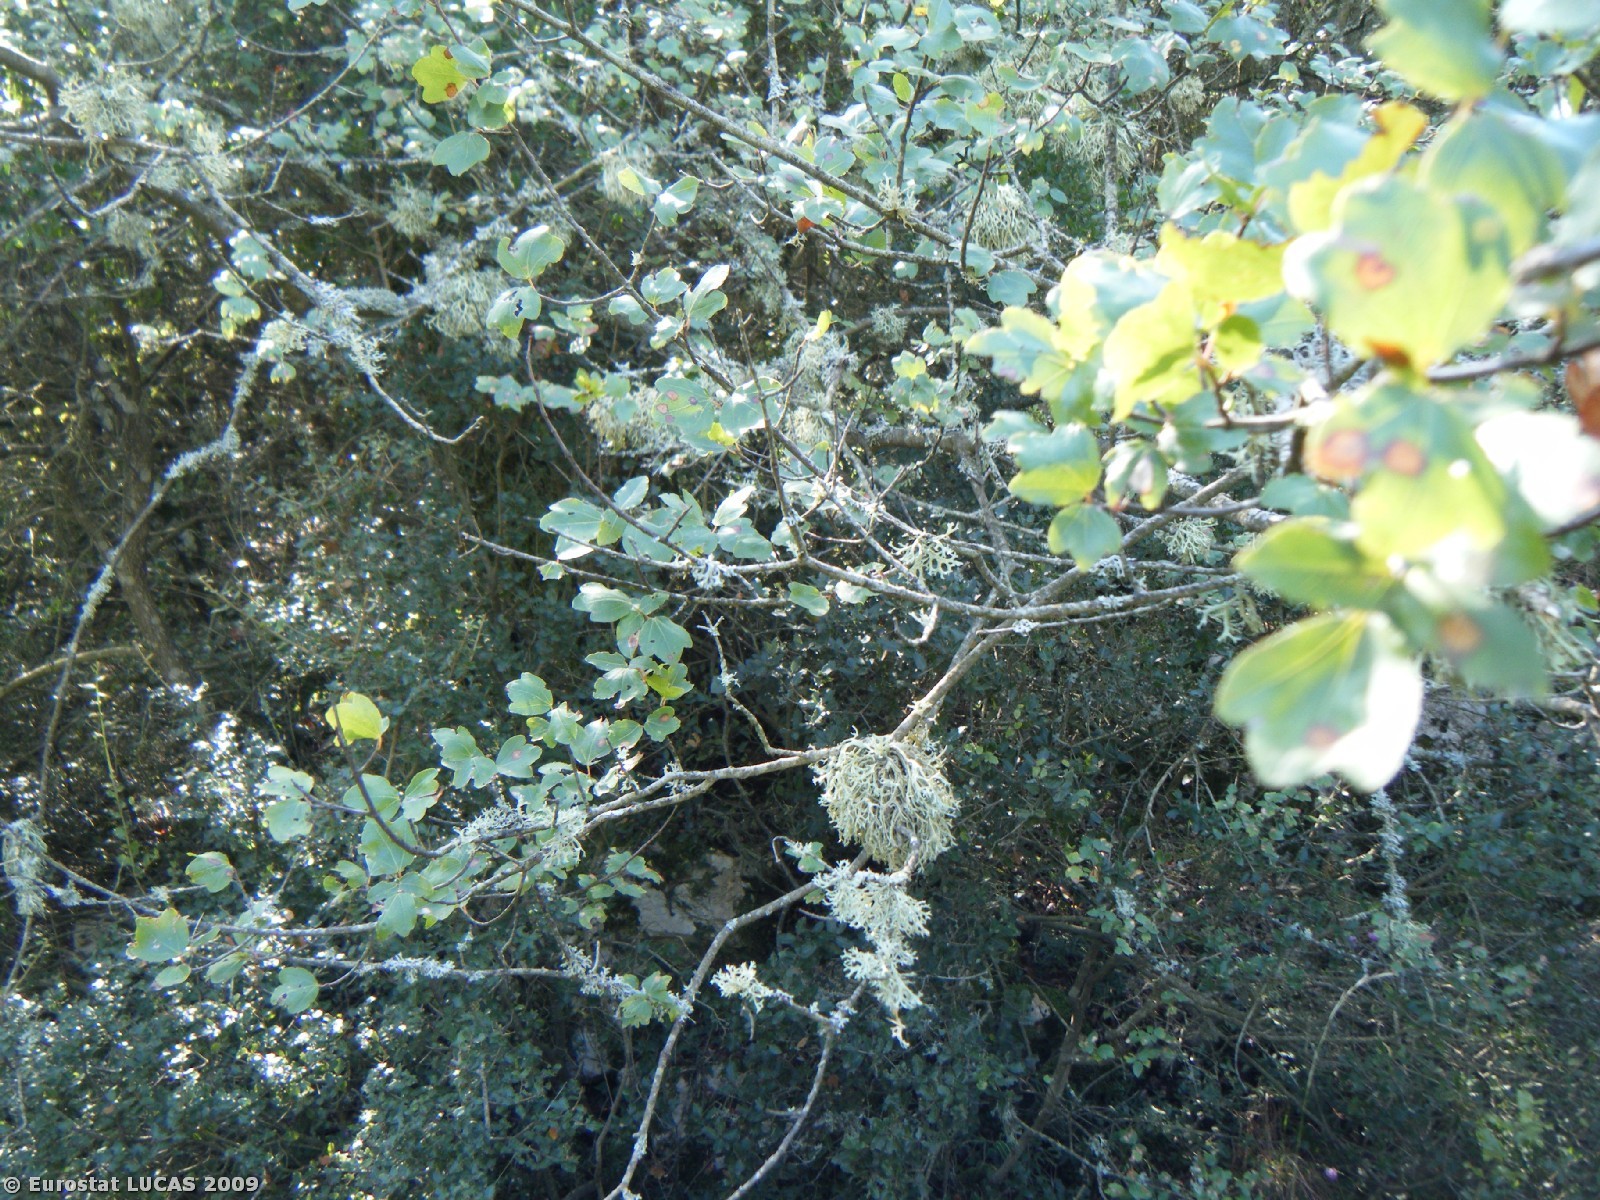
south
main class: Woodland
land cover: Broadleaved woodland
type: thermophilous deciduous forest
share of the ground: > 75 %
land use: Agriculture (excluding fallow land and kitchen gardens)
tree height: > 5 m
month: October
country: GR
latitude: 37.4532
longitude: 22.2027
